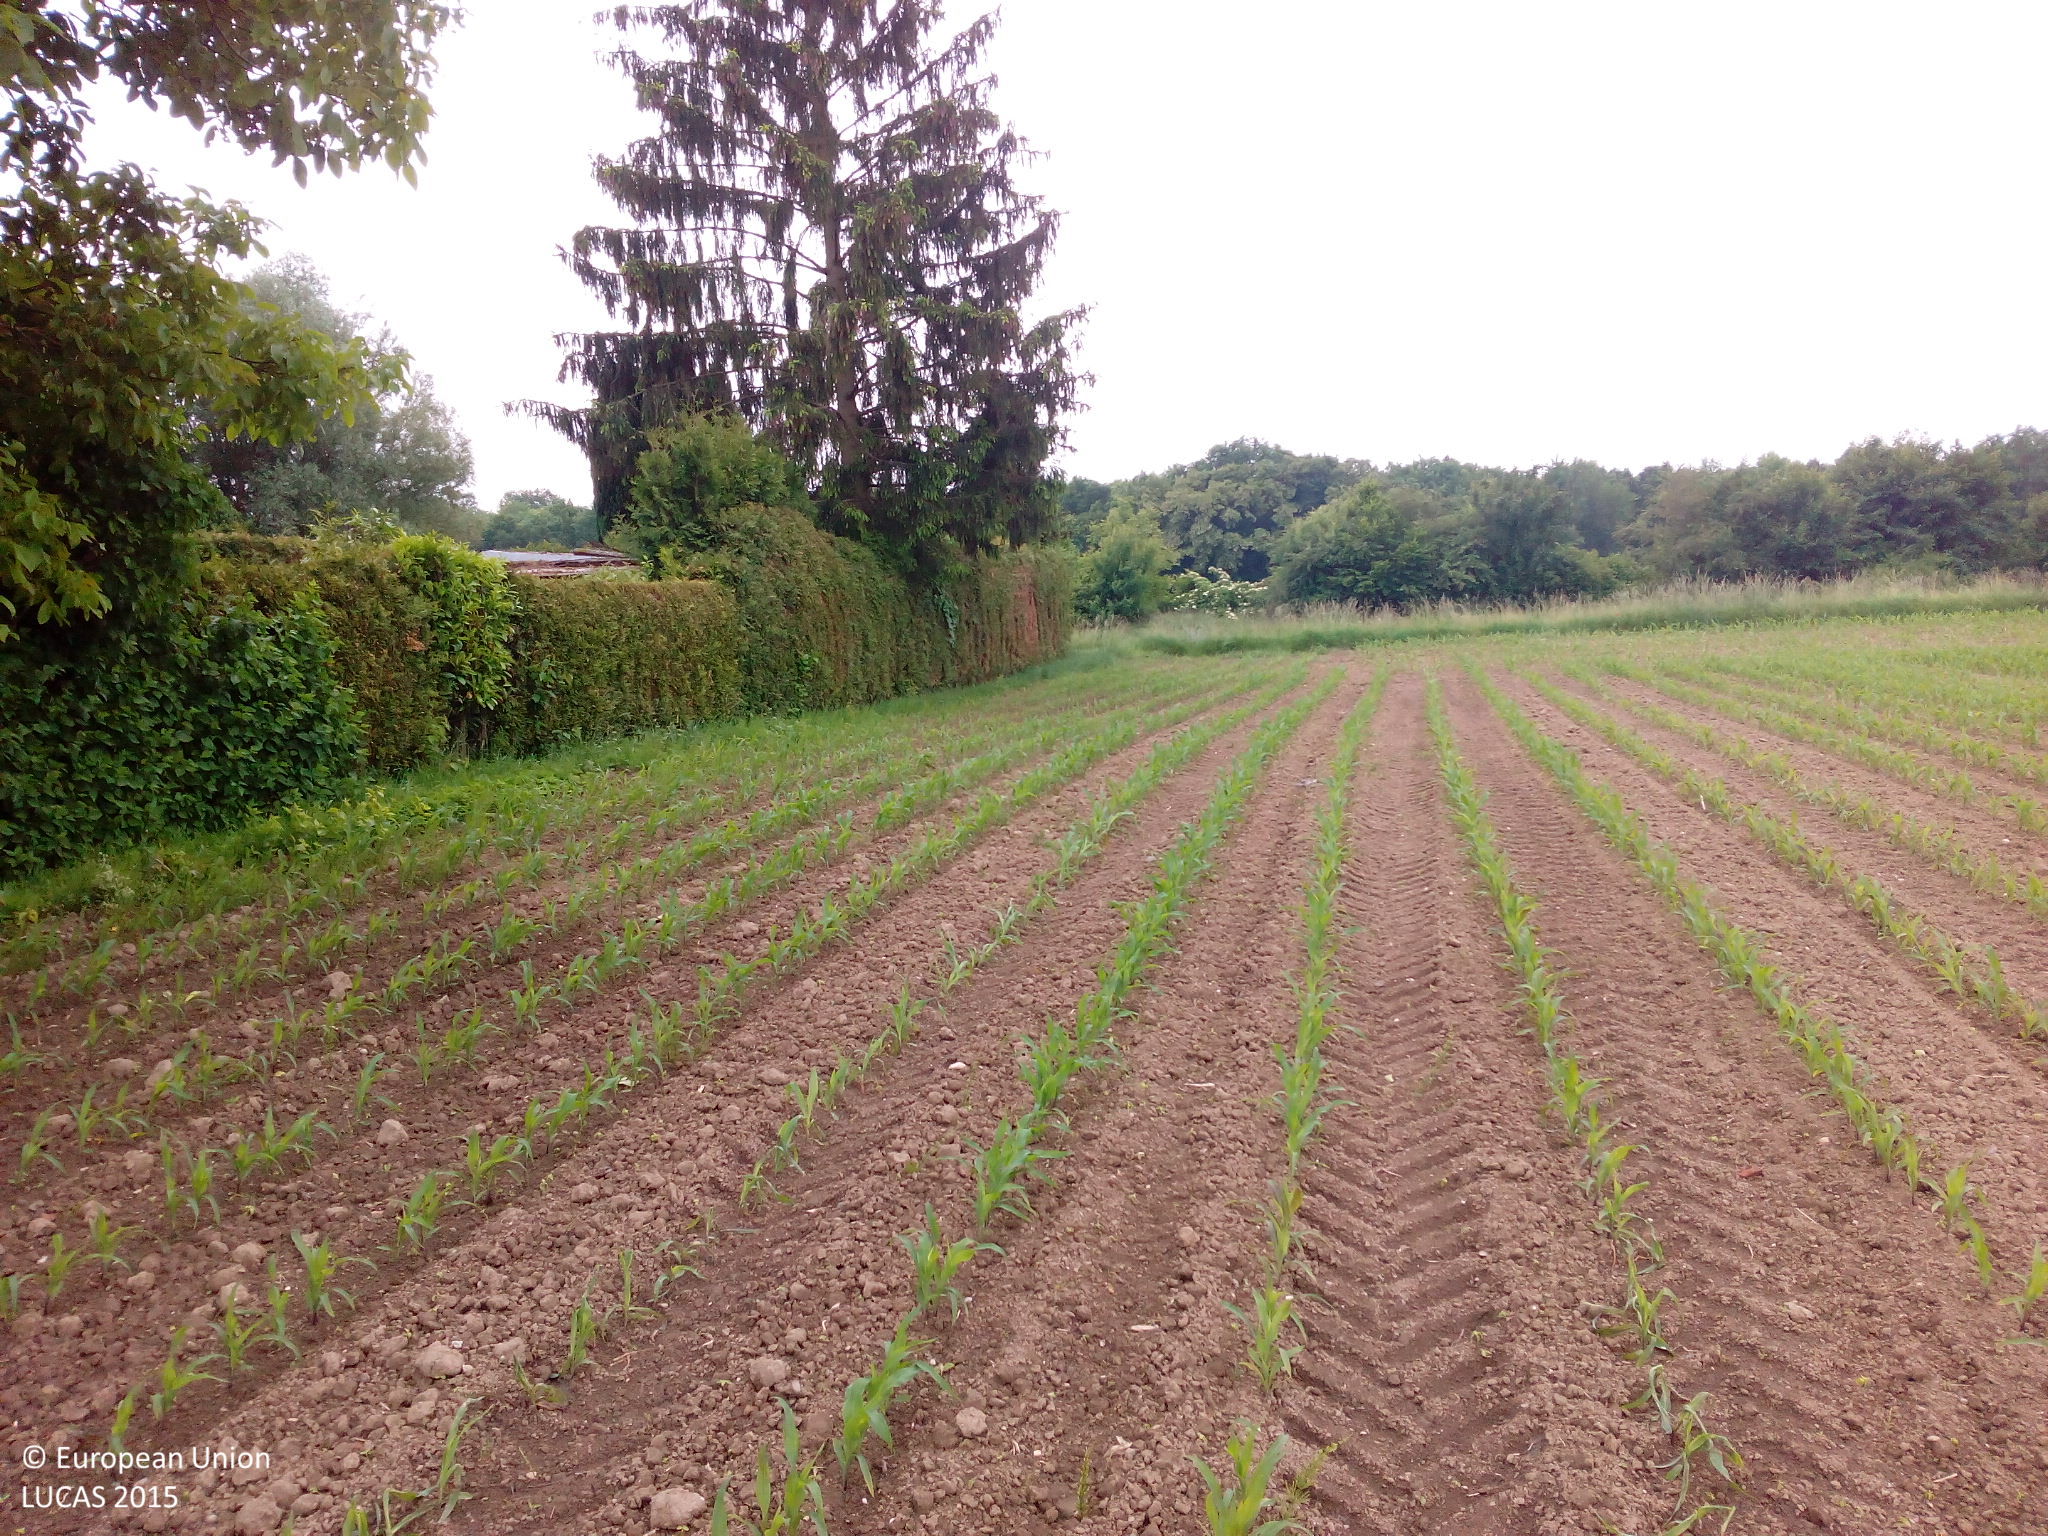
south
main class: Cropland
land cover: Maize
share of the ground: < 10 %
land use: Agriculture (excluding fallow land and kitchen gardens)
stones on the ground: < 10 %
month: May
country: DE
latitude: 48.8741
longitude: 8.1600
